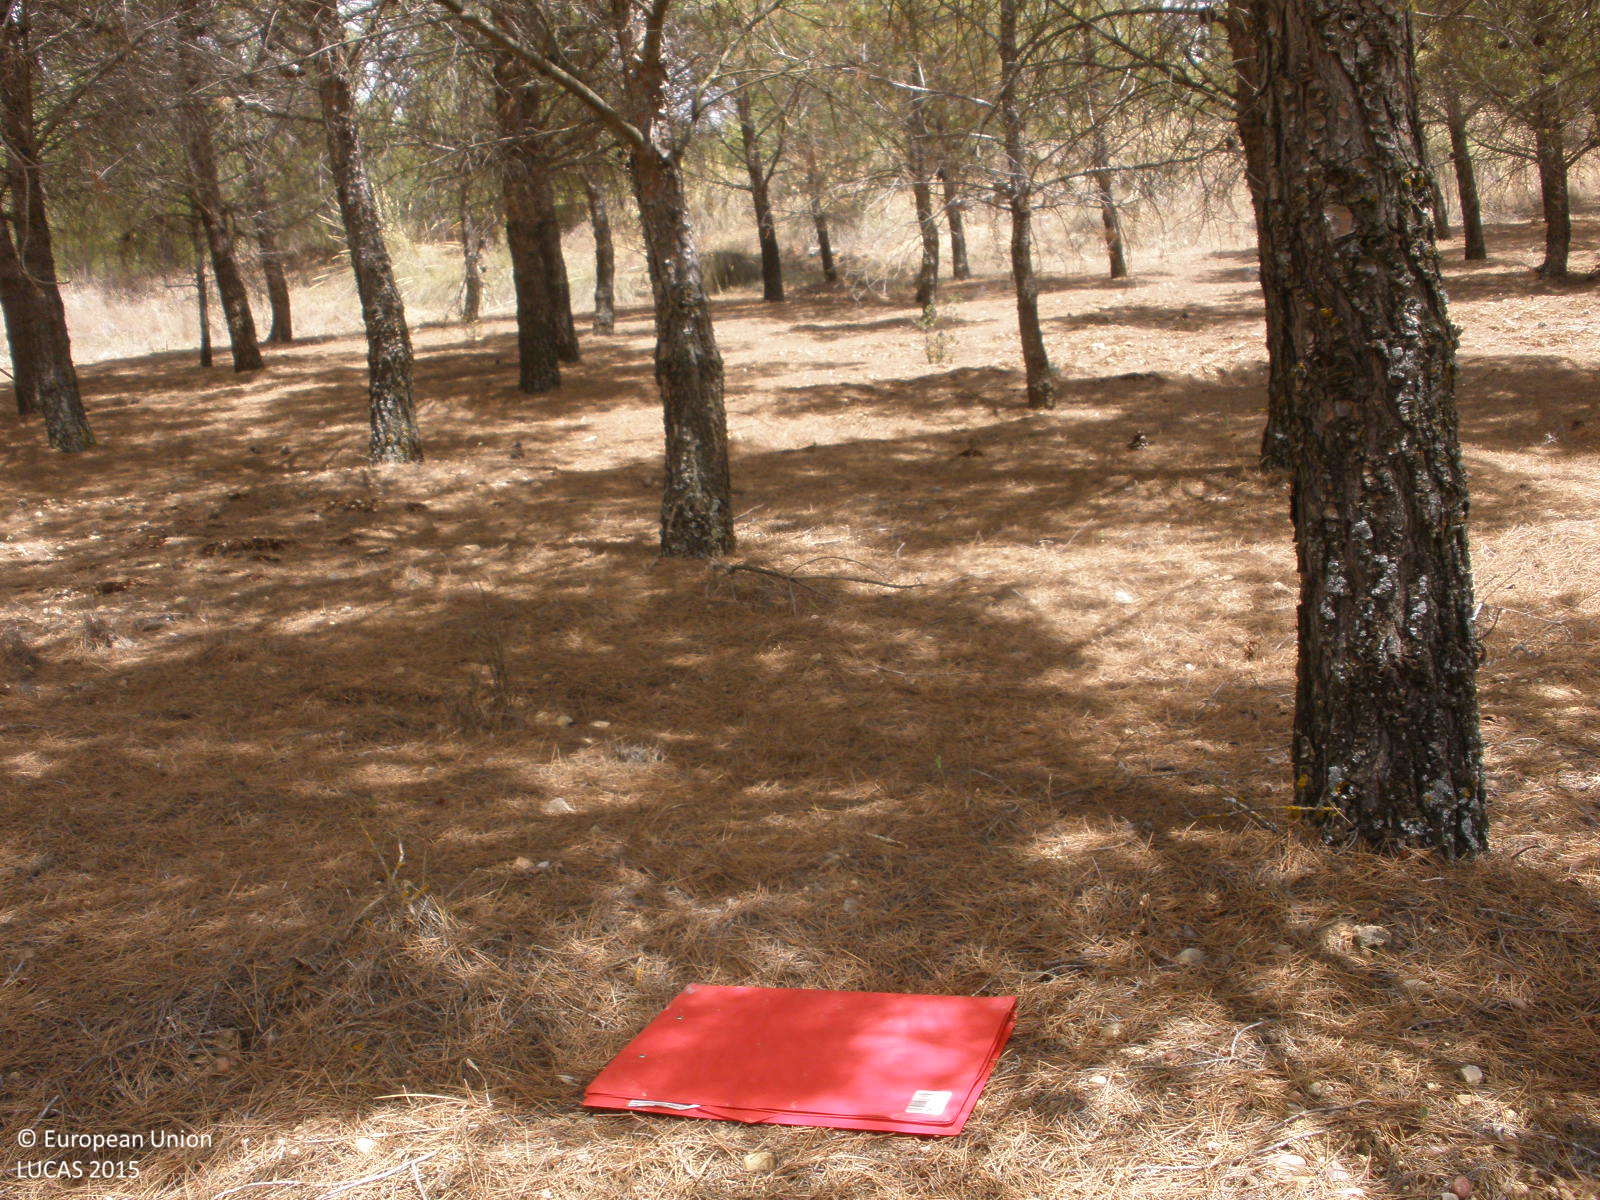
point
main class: Woodland
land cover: Pine dominated coniferous woodland
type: coniferous forest of the mediterranean region
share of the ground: 50 - 75 %
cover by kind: coniferous forest trees 70 %, herbaceous plants 20 %, consolidated bare surface 10 %
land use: Forestry
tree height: > 5 m
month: July
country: ES
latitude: 39.8194
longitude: -3.4024
